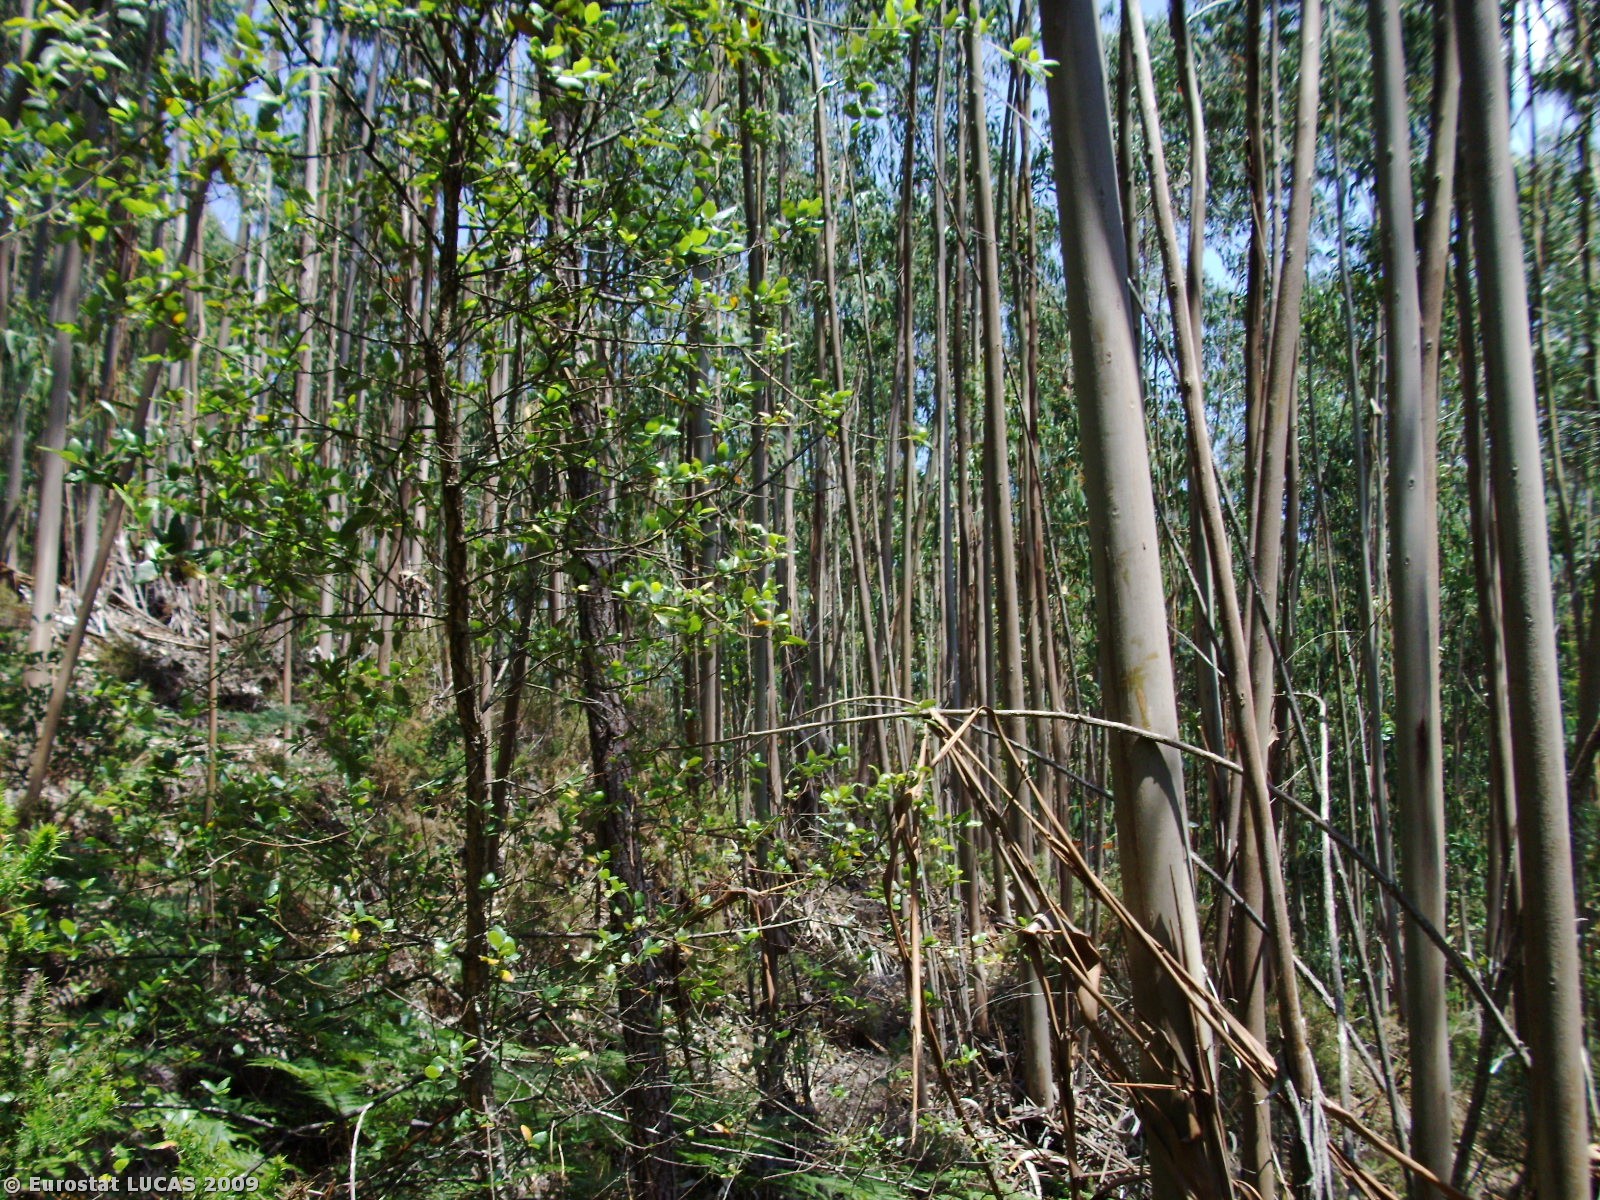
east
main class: Woodland
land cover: Broadleaved woodland
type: plantations and self-sown exotic forest
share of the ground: > 75 %
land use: Forestry
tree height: > 5 m
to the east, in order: Broadleaved woodland; Tracks; Broadleaved woodland
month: May
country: PT
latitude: 40.2684
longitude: -8.3931
